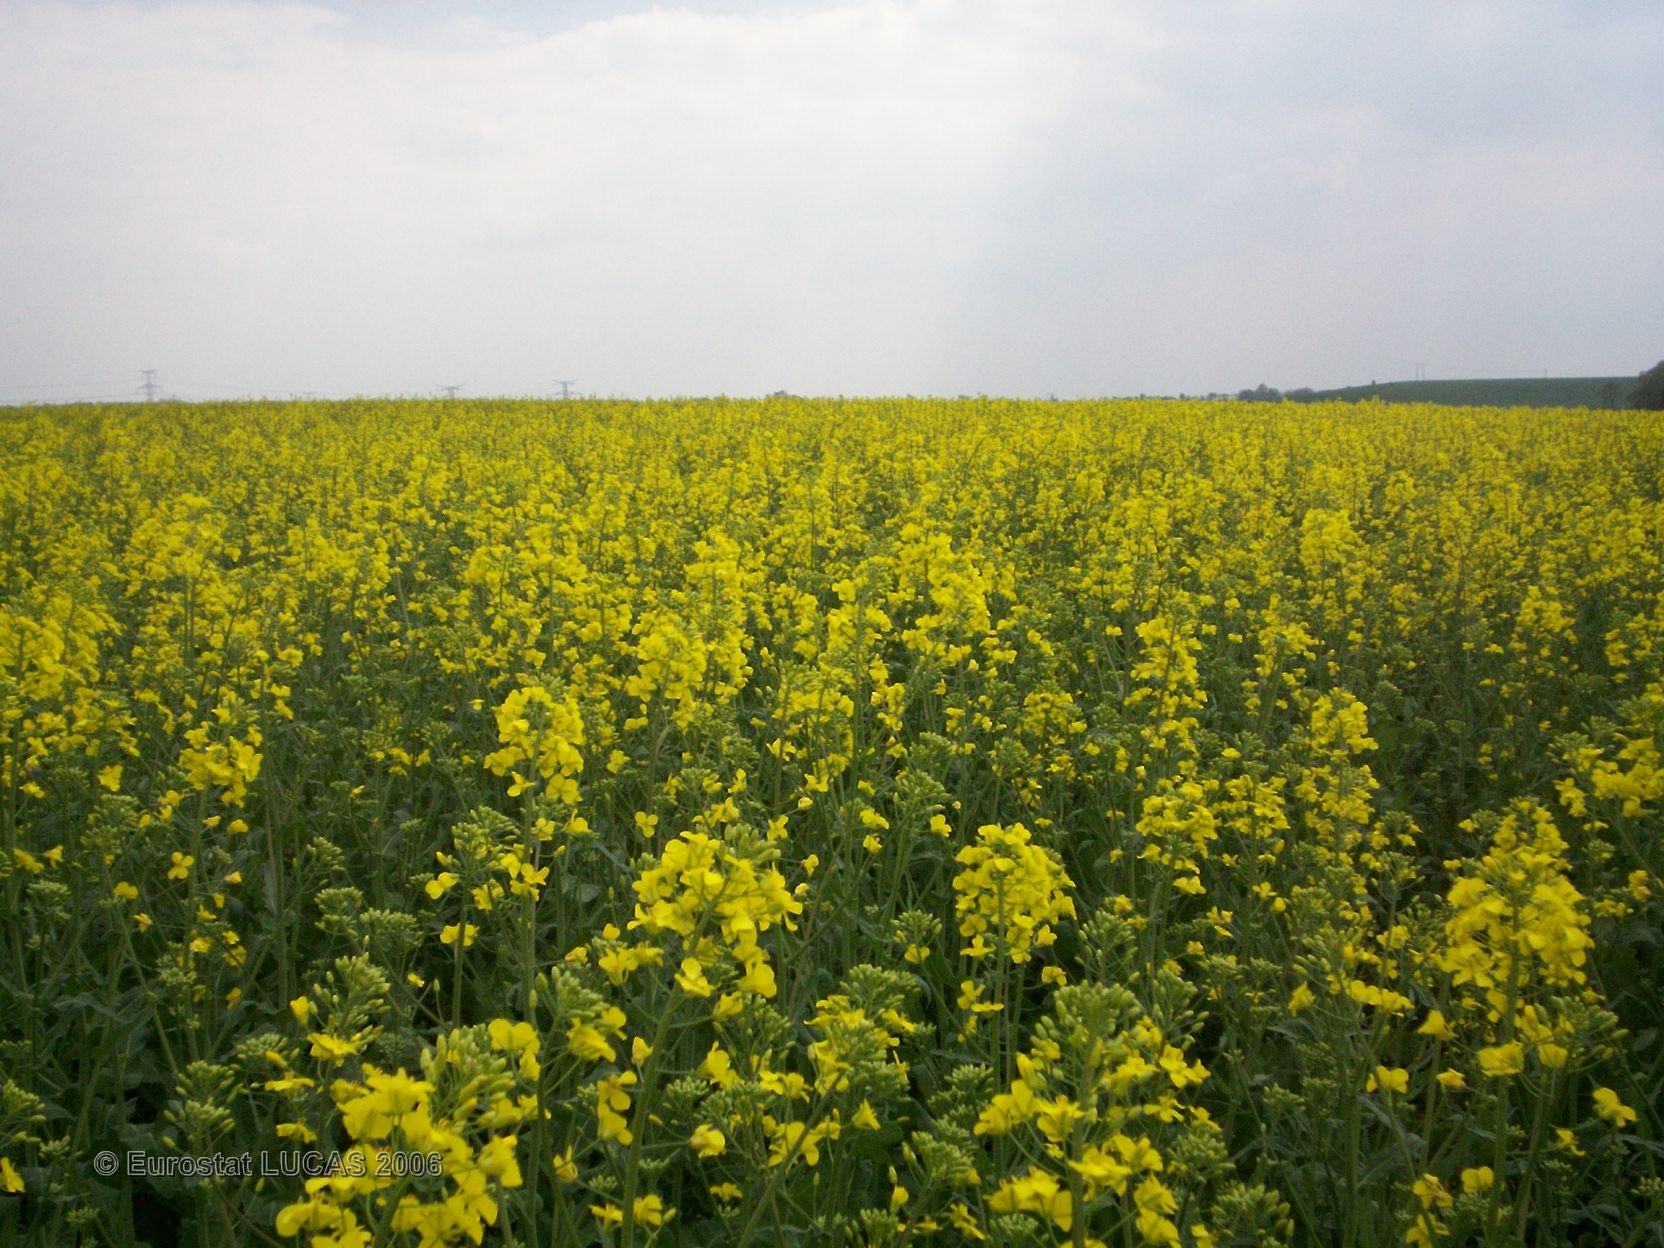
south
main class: Cropland
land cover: Rape and turnip rape
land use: Agriculture (excluding fallow land and kitchen gardens)
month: April
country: FR
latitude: 47.1548
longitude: 3.0447
